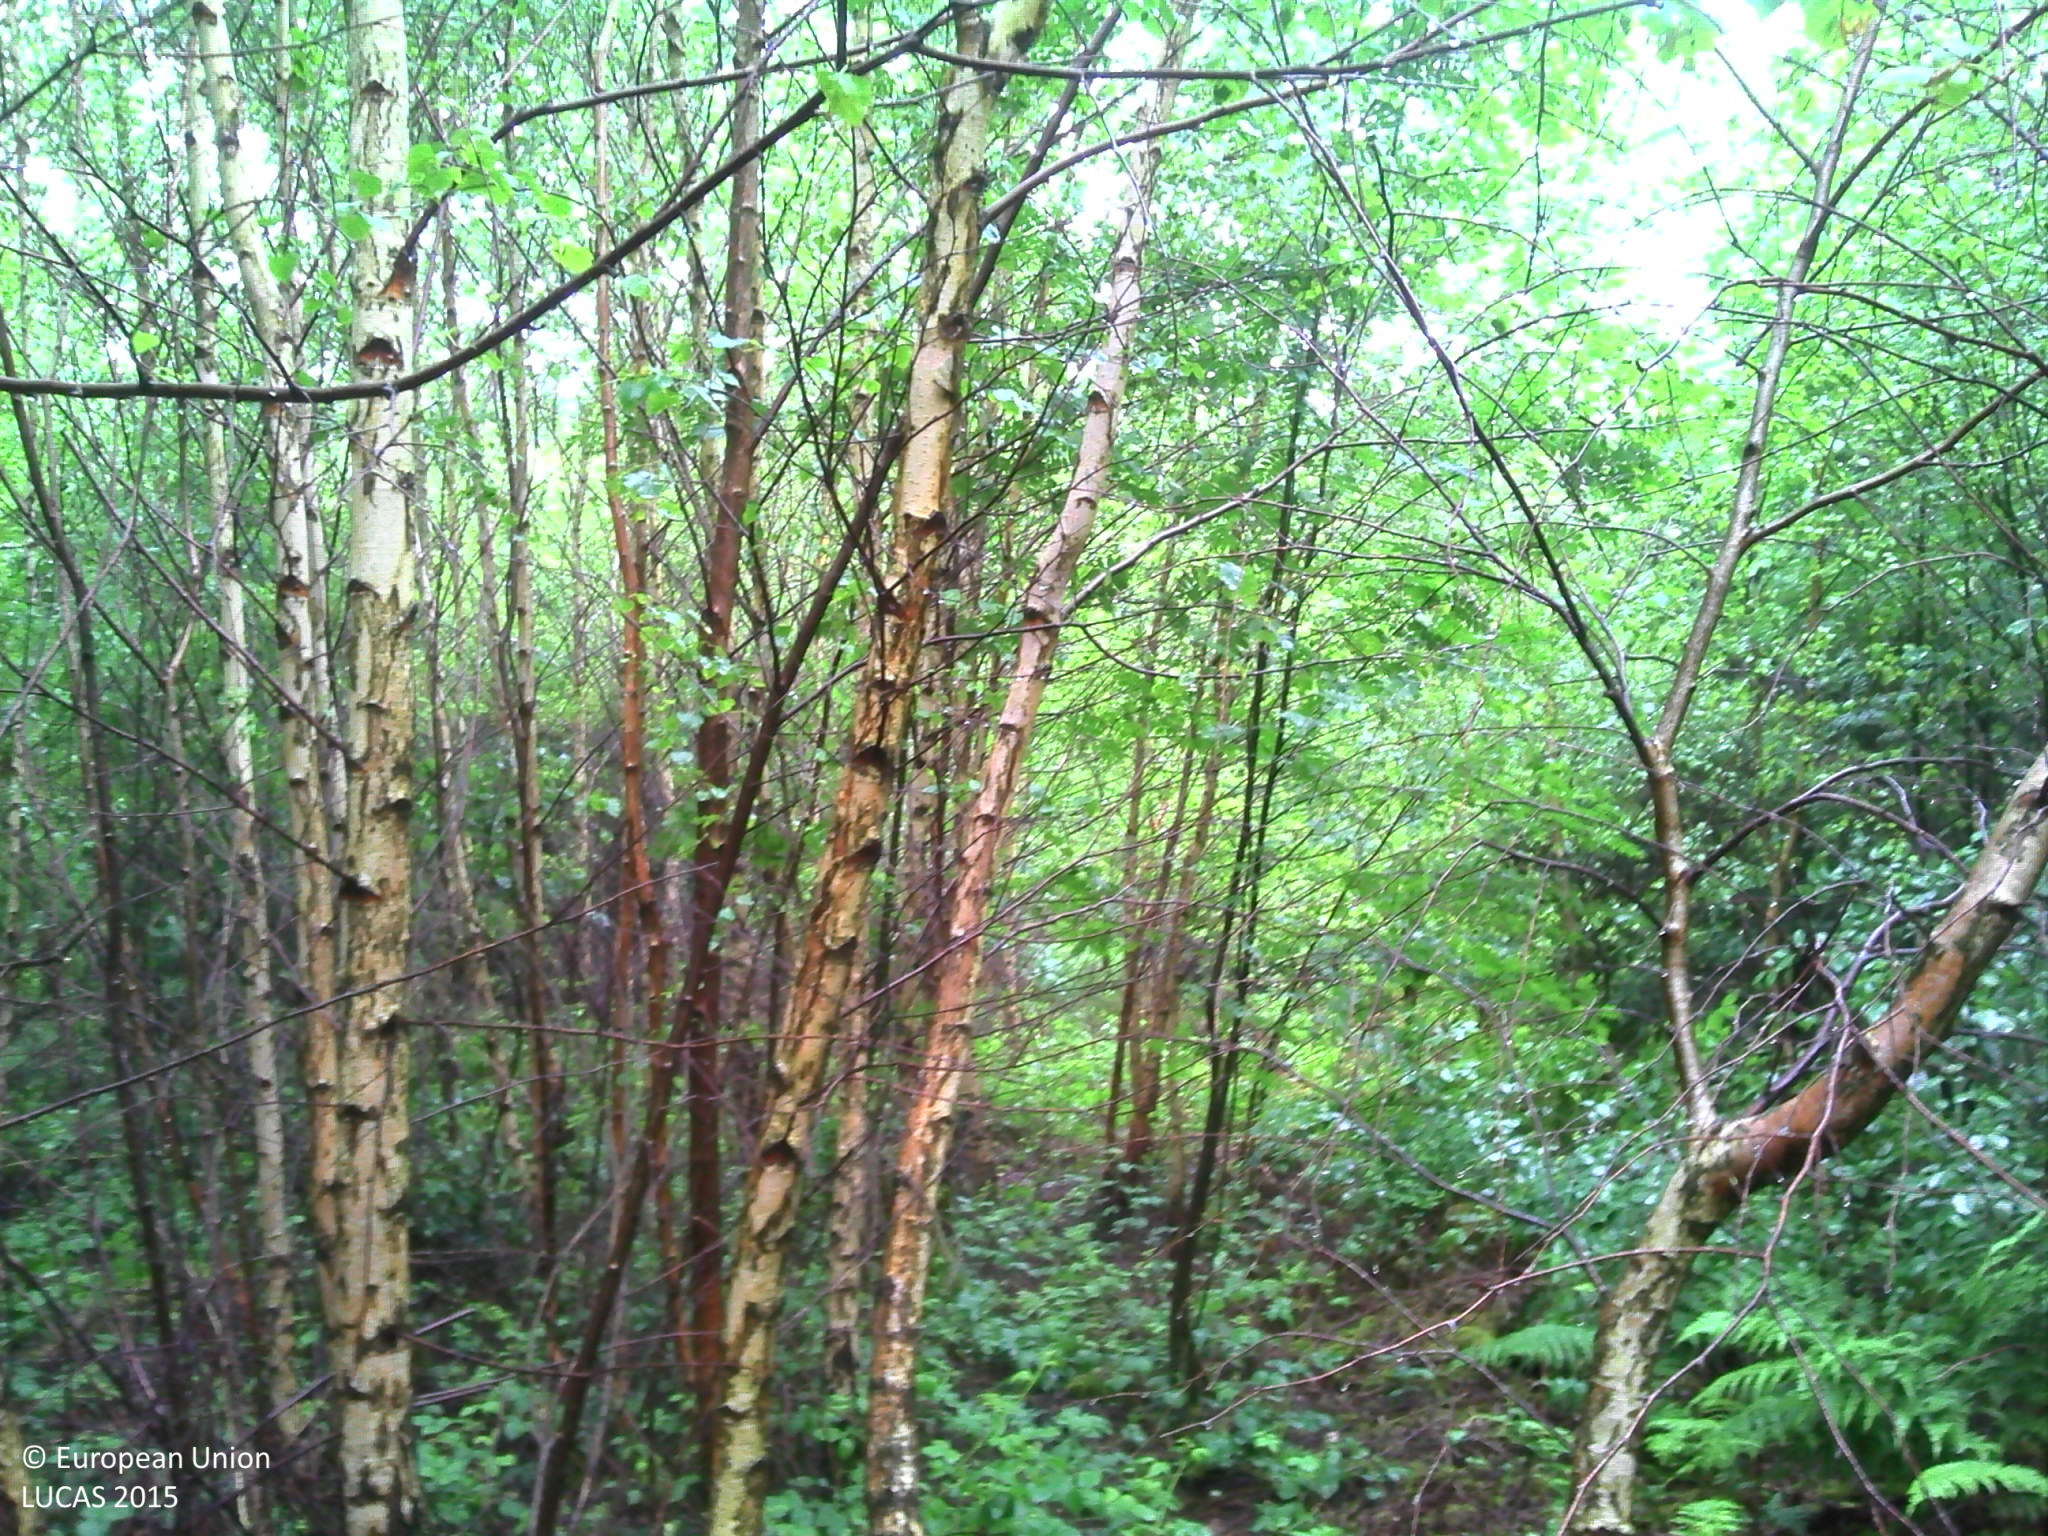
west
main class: Woodland
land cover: Broadleaved woodland
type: acidophilous oak and oak-birch forest
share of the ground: 50 - 75 %
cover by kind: broadleaved forest trees 70 %, shrubs 20 %, herbaceous plants 10 %
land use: Forestry
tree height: > 5 m
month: June
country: BE
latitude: 50.2035
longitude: 5.5009
